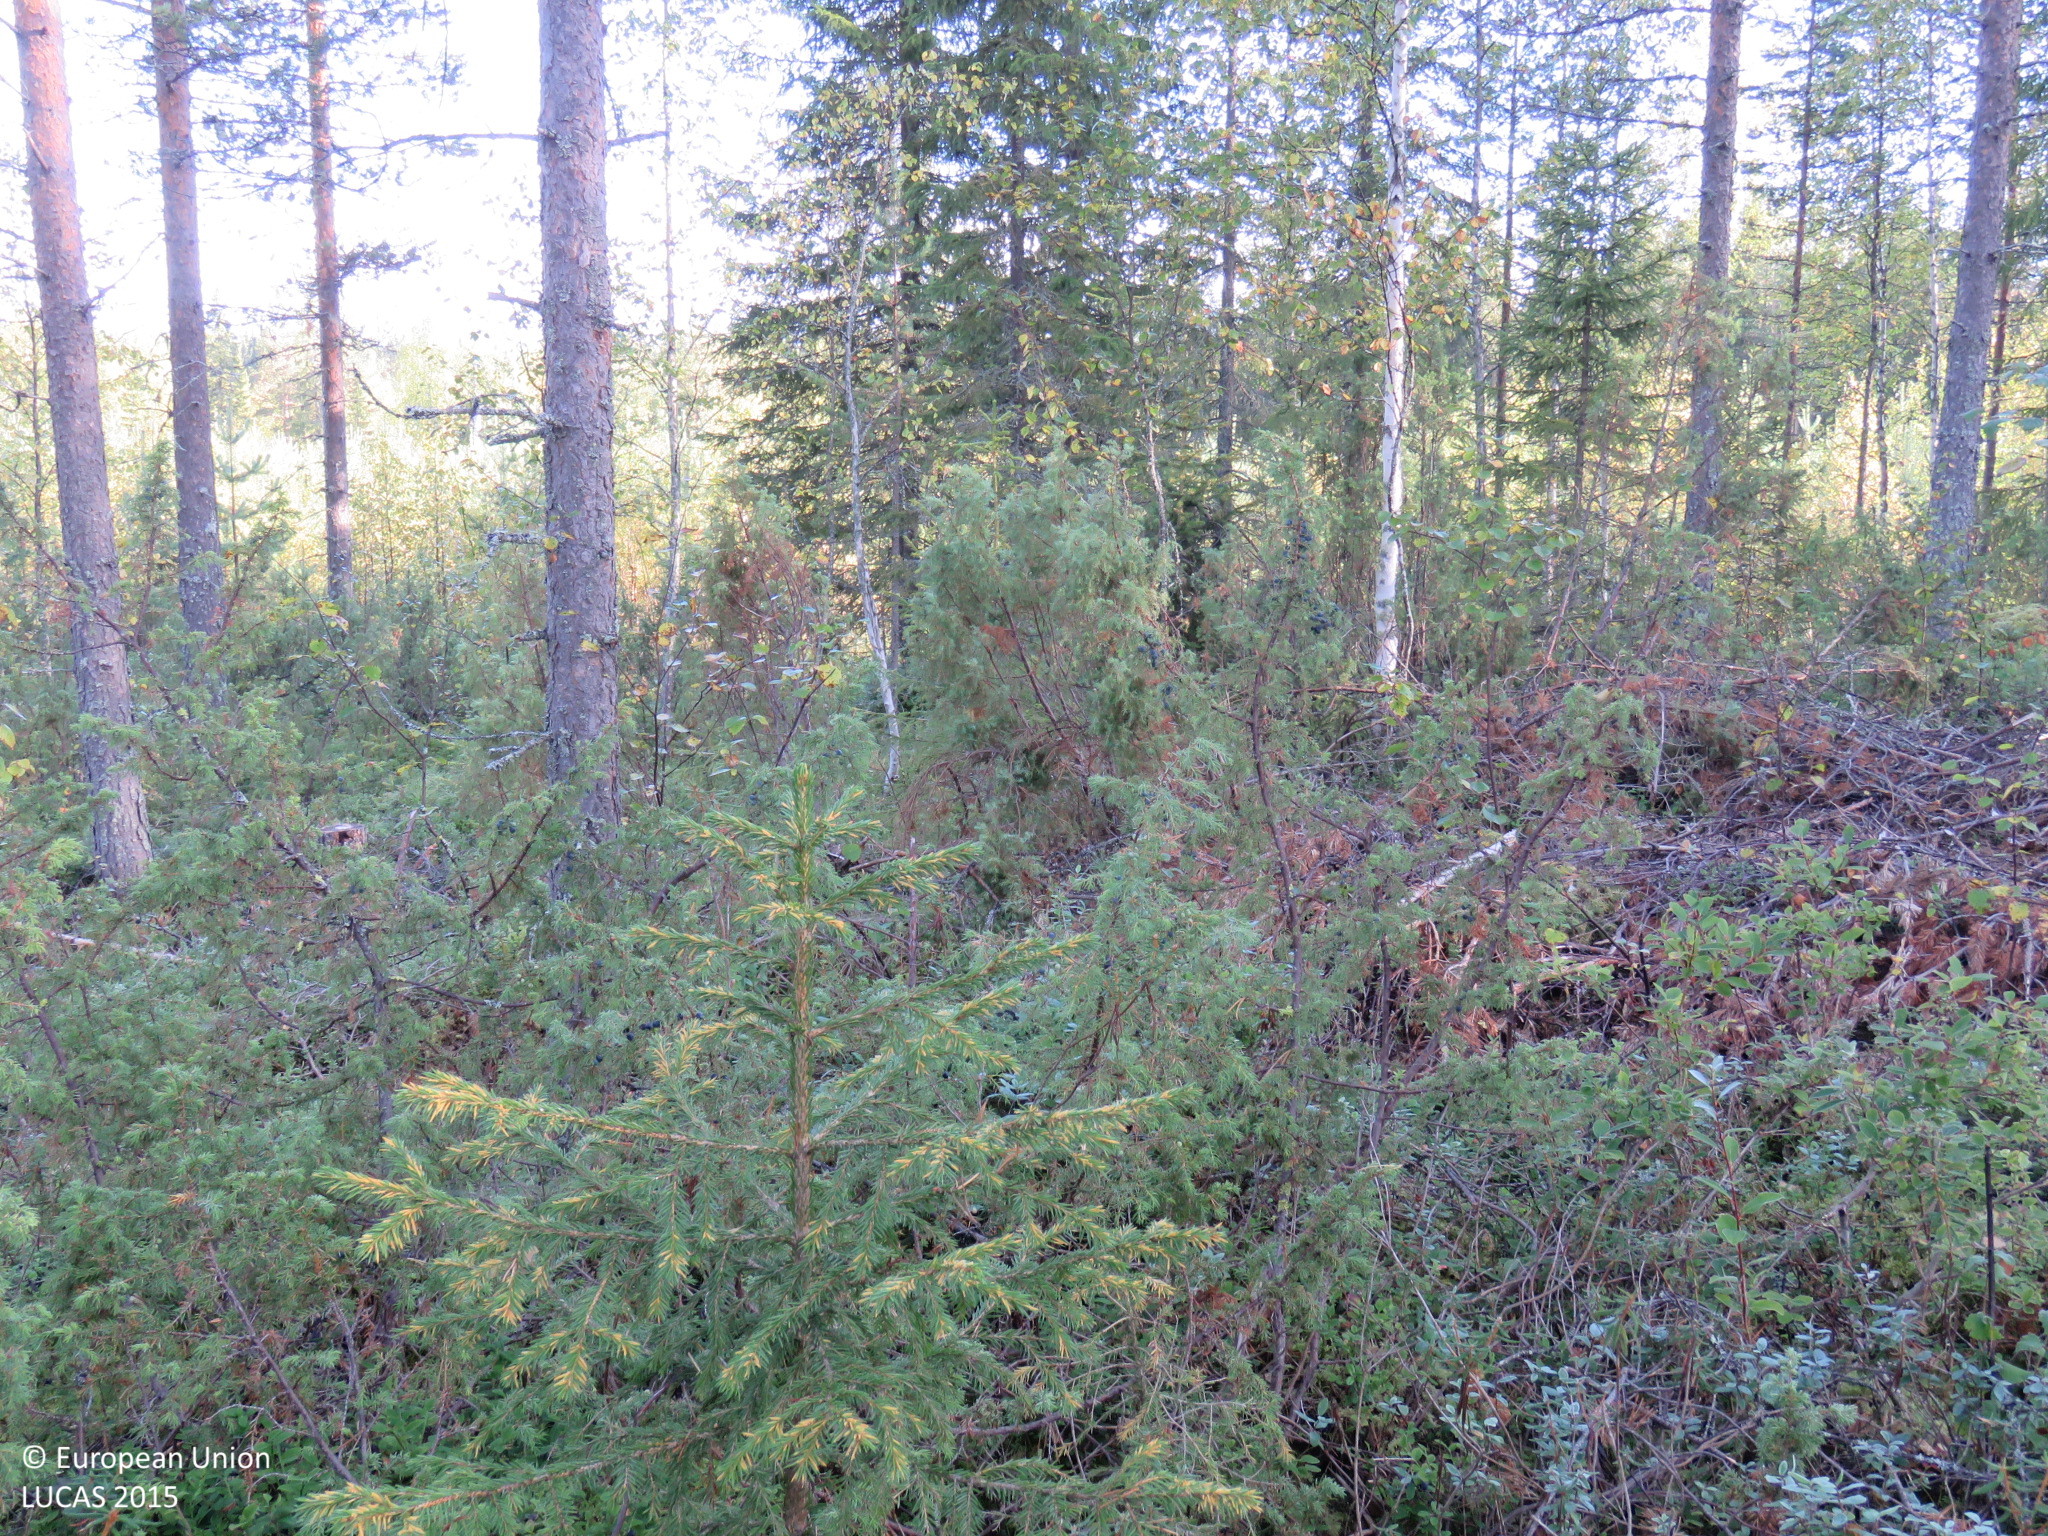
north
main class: Woodland
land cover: Pine dominated mixed woodland
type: boreal forest
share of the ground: > 75 %
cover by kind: coniferous forest trees 45 %, broadleaved forest trees 35 %, shrubs 20 %
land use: Forestry
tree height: > 5 m
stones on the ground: < 10 %
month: September
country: FI
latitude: 65.4745
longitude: 27.5546
